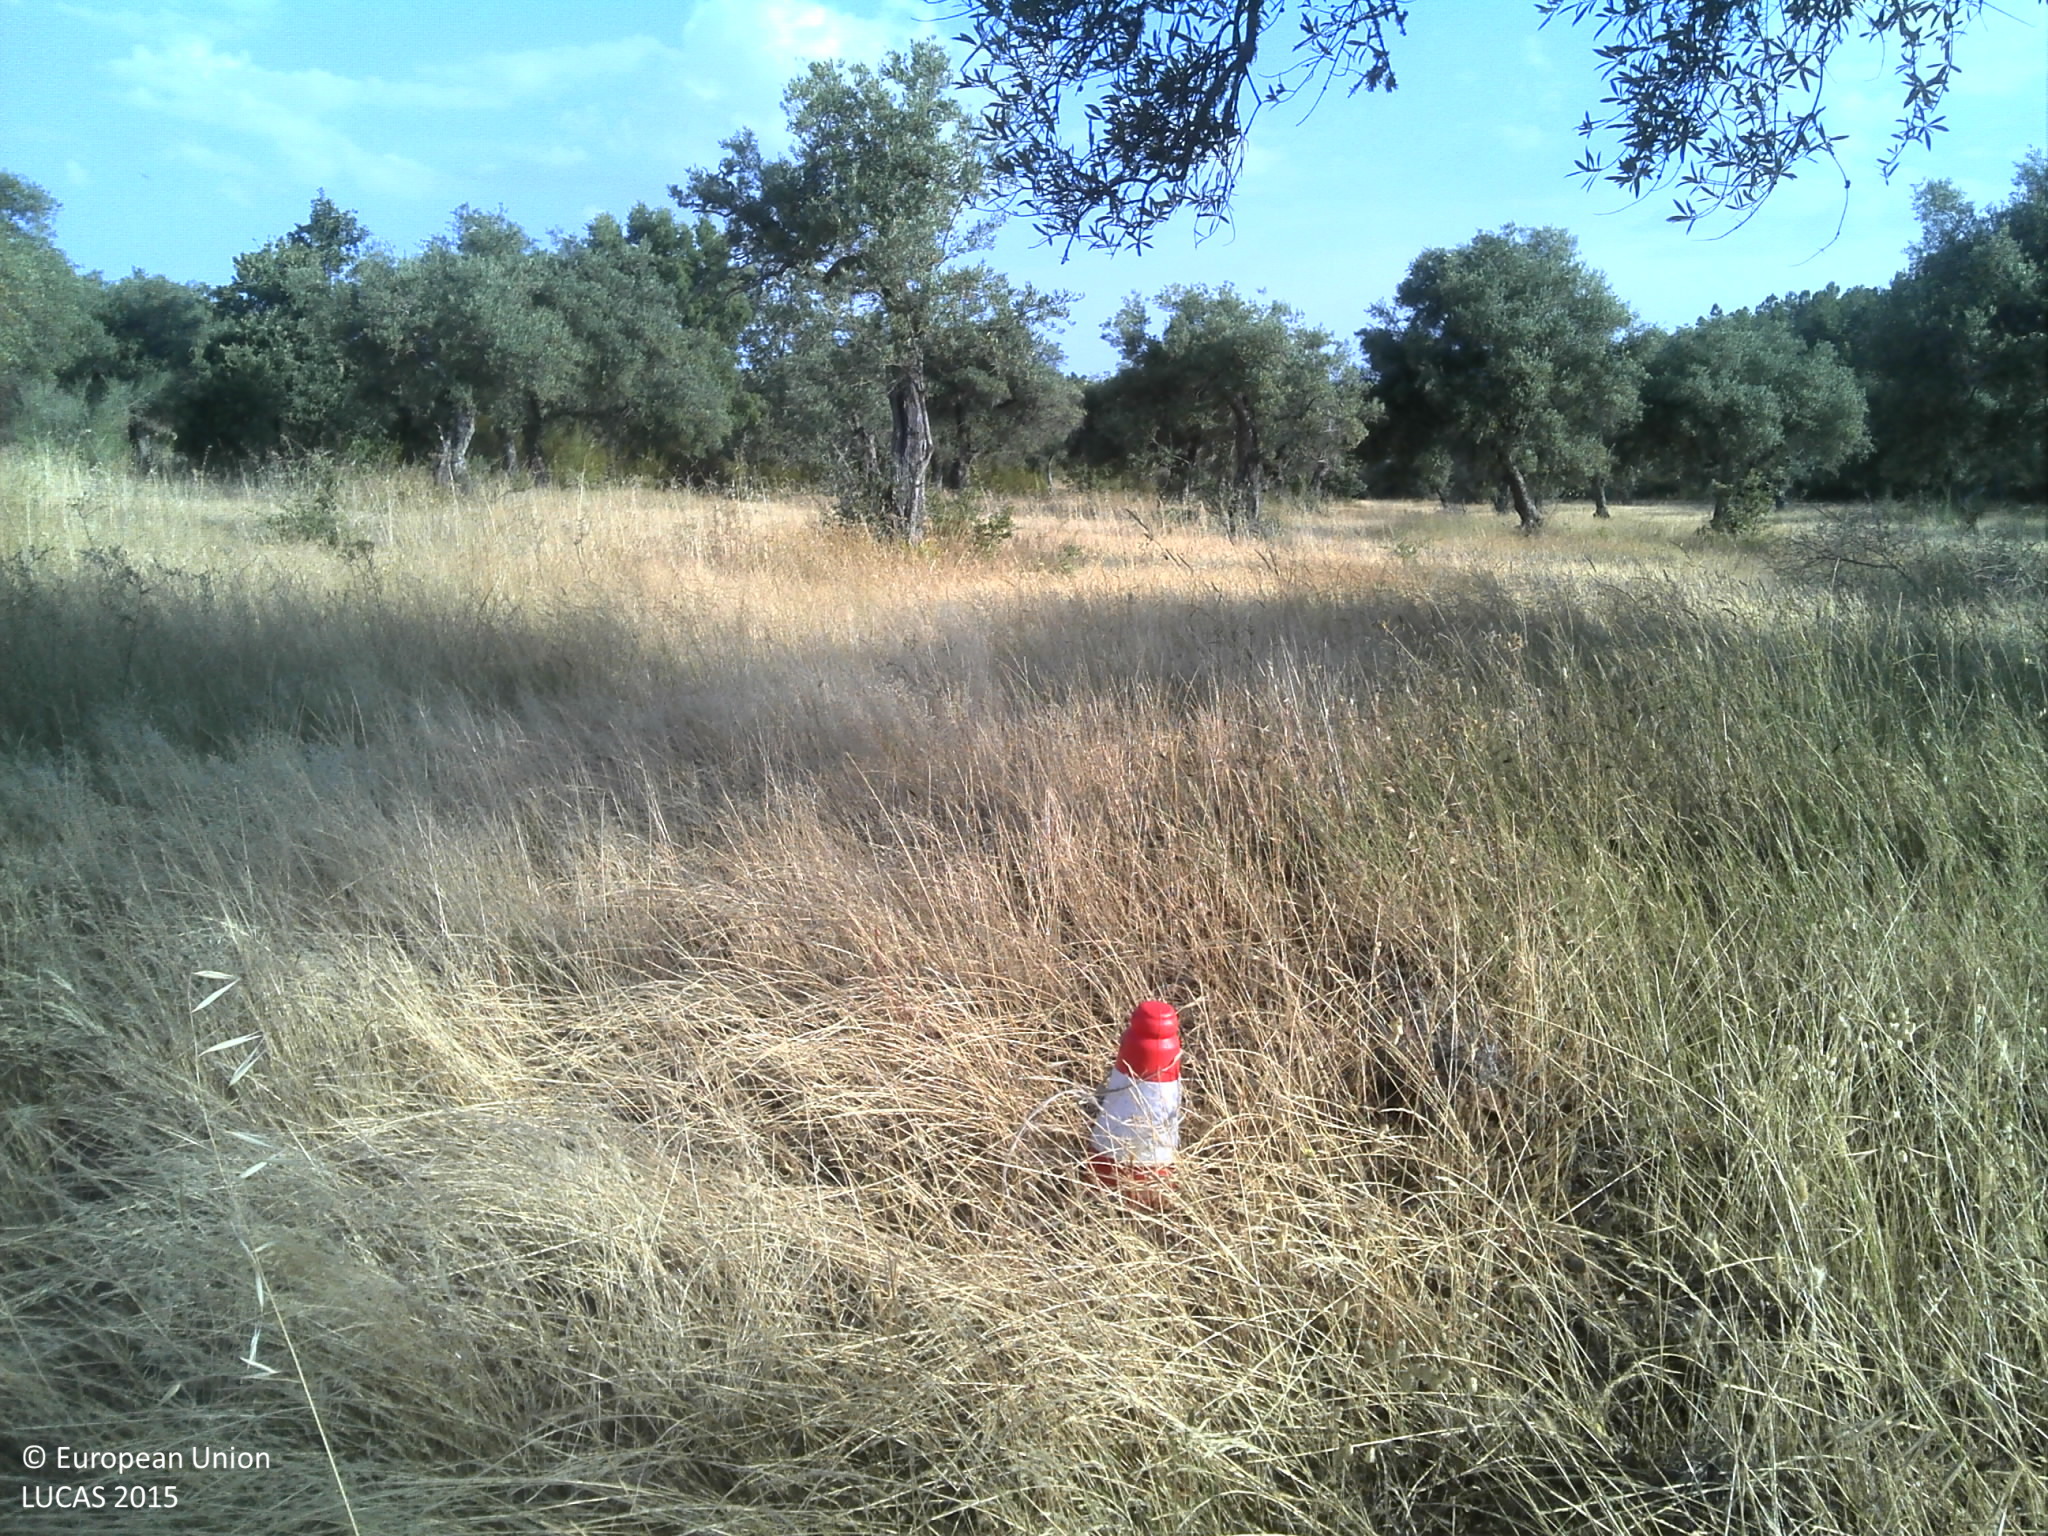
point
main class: Cropland
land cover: Olive groves
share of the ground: 25 - 50 %
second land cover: Spontaneously vegetated surfaces
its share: 25 - 50 %
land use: Agriculture (excluding fallow land and kitchen gardens)
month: June
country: PT
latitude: 40.0971
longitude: -7.1149
